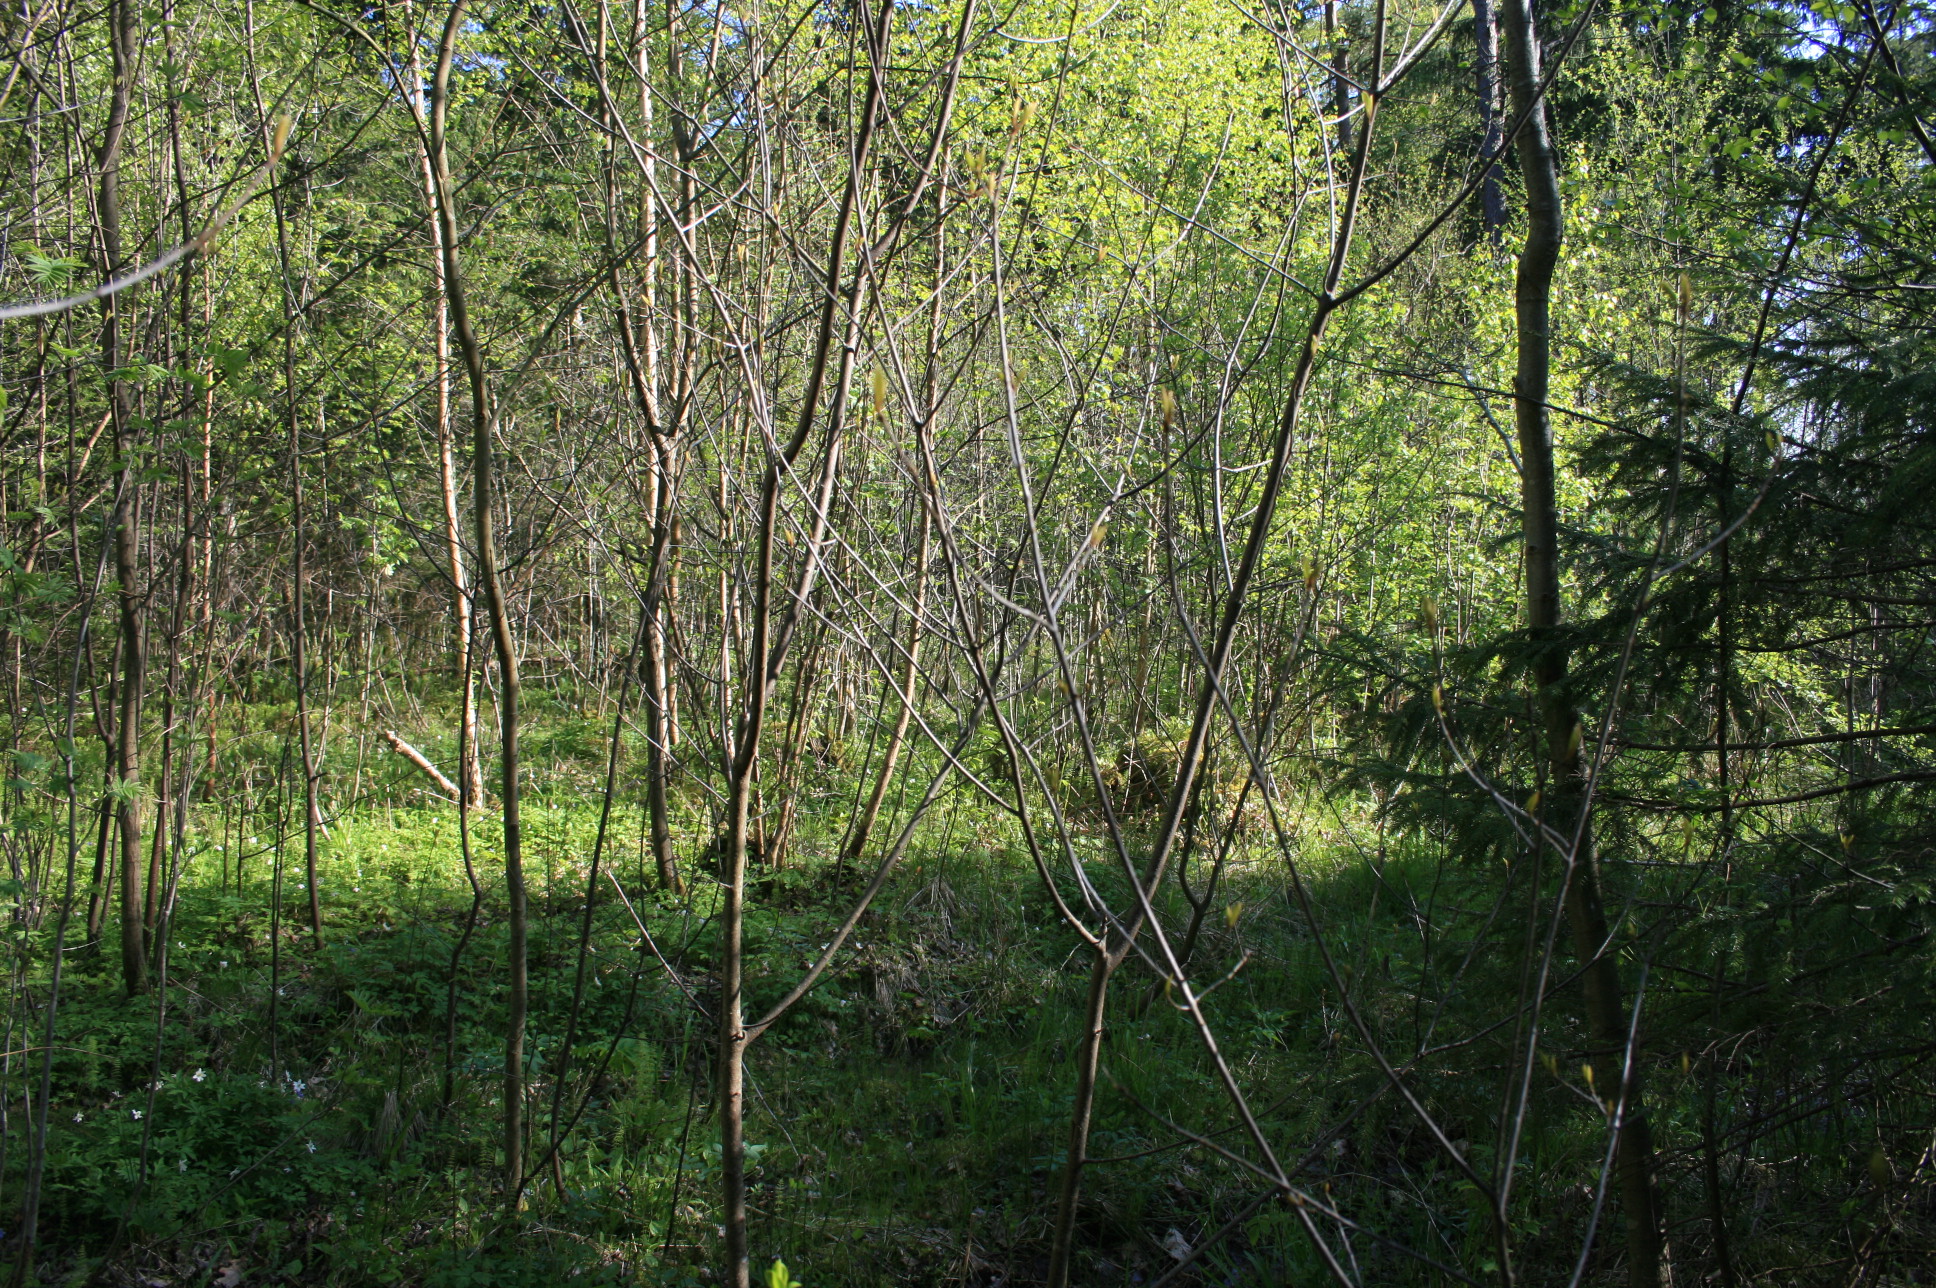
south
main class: Woodland
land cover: Other mixed woodland
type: hemiboreal forest and nemoral coniferous forest and mixed broadleaved-coniferous forest
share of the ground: > 75 %
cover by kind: coniferous forest trees 70 %, broadleaved forest trees 25 %, lichens and mosses 5 %
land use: Forestry
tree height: > 5 m
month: May
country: LT
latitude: 55.9805
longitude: 21.4708
